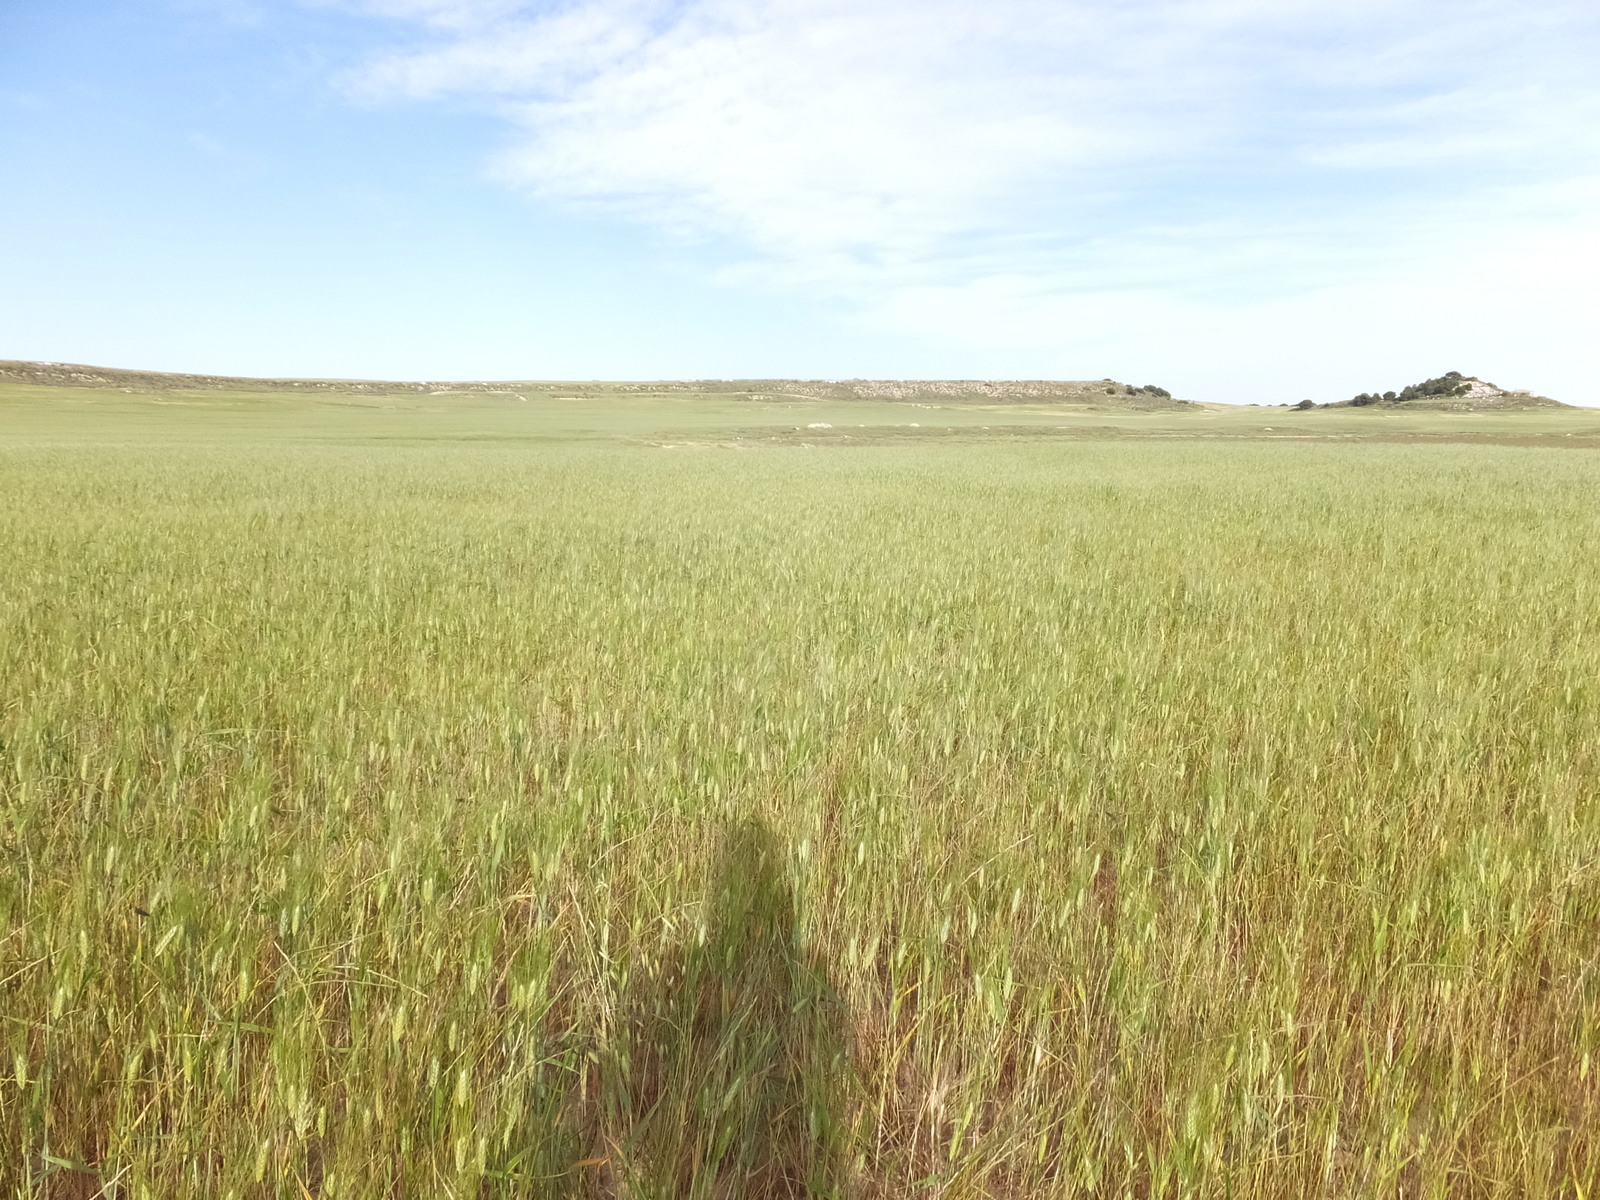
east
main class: Cropland
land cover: Durum wheat
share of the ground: > 75 %
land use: Agriculture (excluding fallow land and kitchen gardens)
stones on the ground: < 10 %
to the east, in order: Durum wheat; Shrubland without tree cover
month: May
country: ES
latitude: 41.3698
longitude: -0.2368
